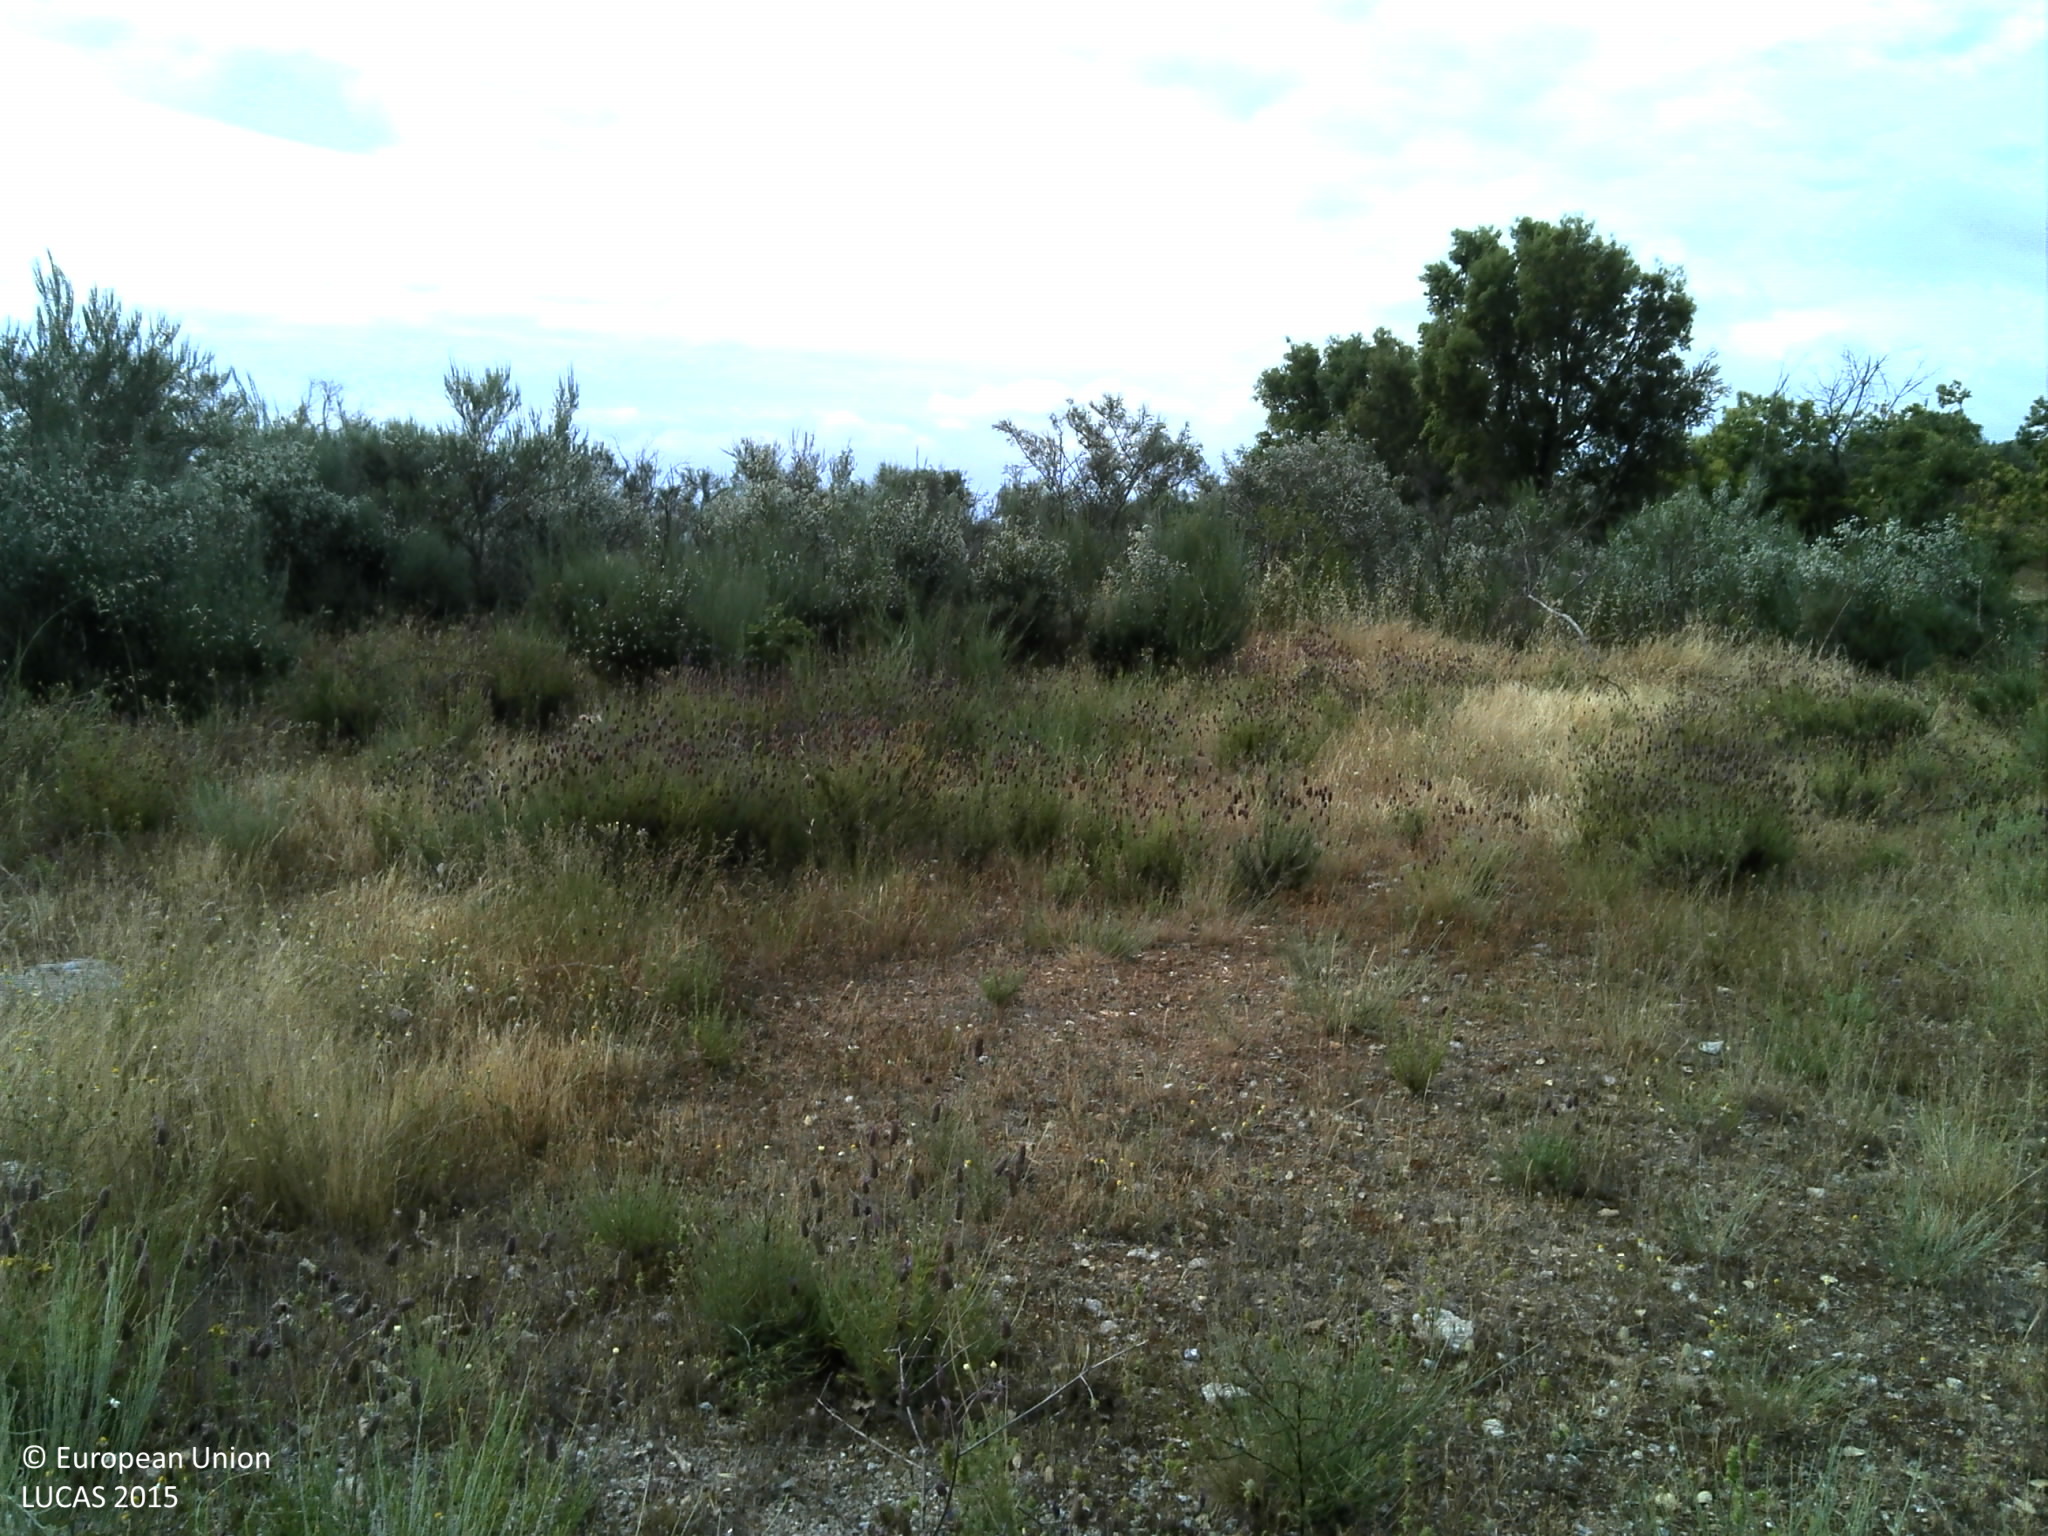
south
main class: Grassland
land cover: Grassland without tree/shrub cover
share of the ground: 10 - 25 %
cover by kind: consolidated bare surface 60 %, unconsolidated bare surface 20 %, herbaceous plants 15 %, shrubs 5 %
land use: Semi-natural and natural areas not in use
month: June
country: PT
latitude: 41.3909
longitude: -6.9873
